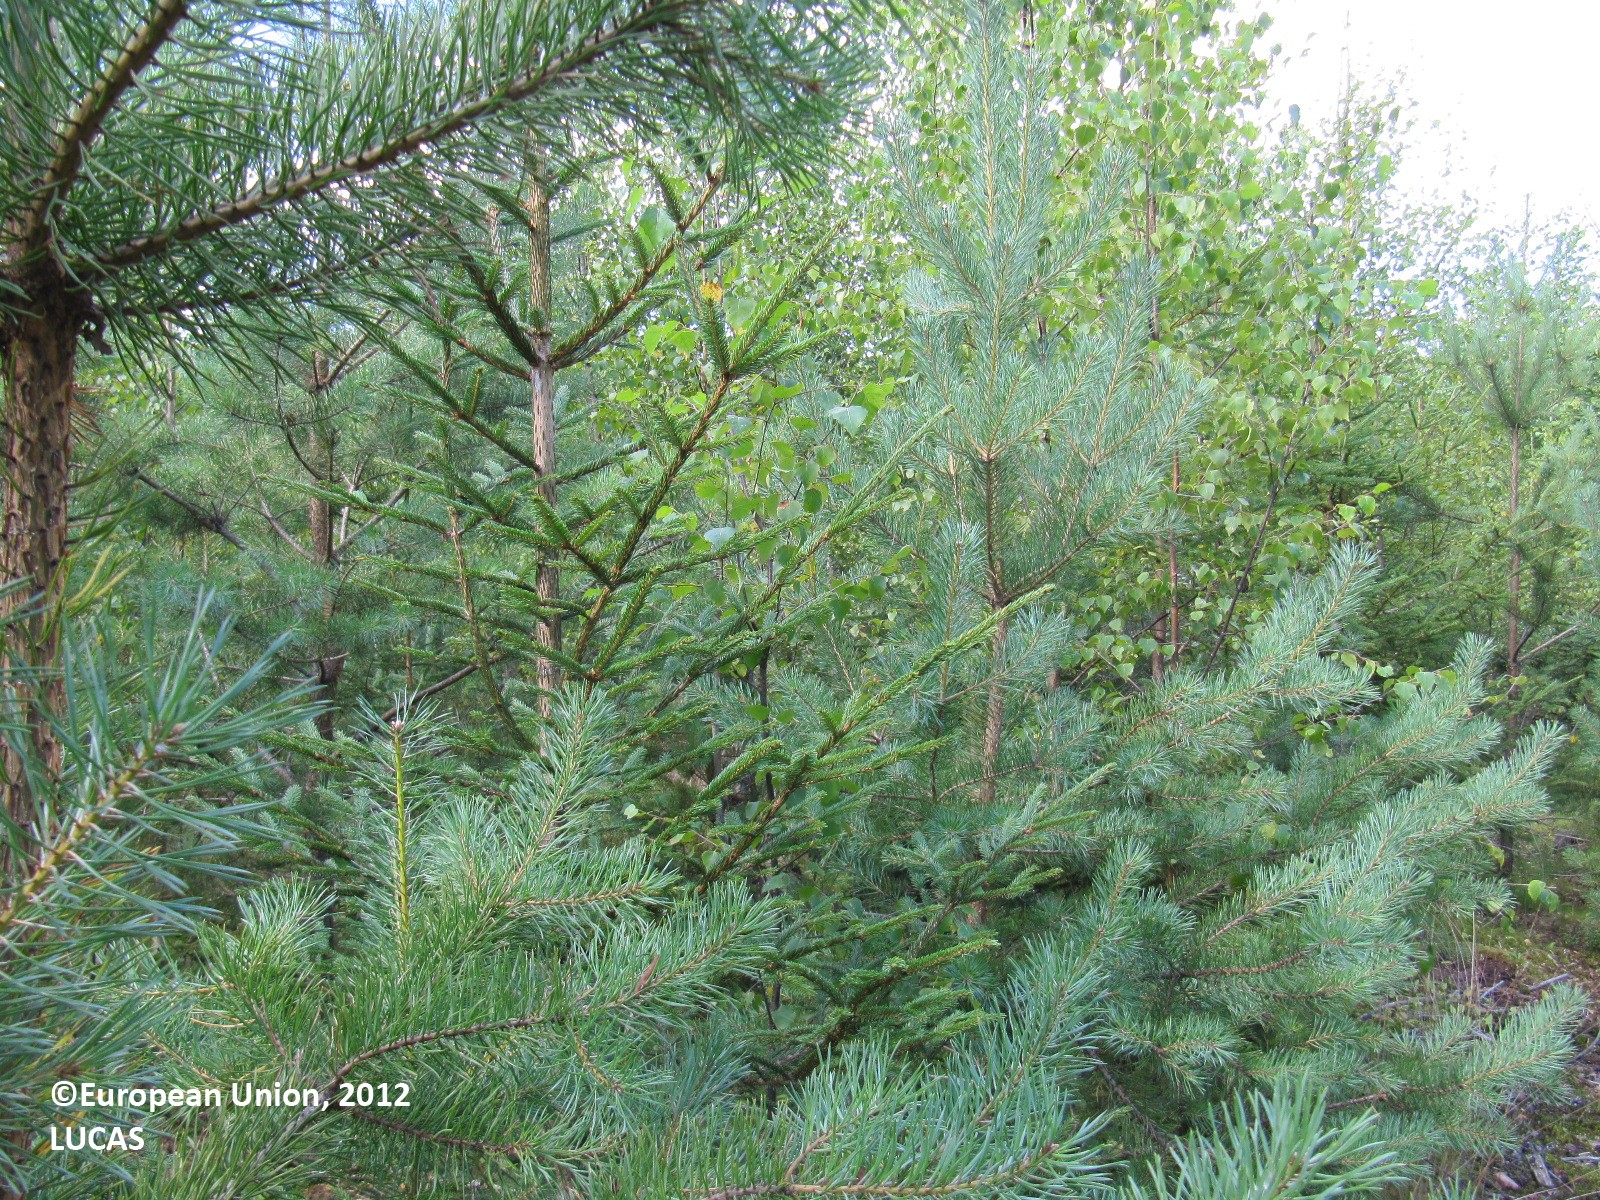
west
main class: Woodland
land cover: Other mixed woodland
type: boreal forest
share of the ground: 50 - 75 %
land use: Forestry
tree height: < 5 m
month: August
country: FI
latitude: 60.6018
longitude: 23.1747
